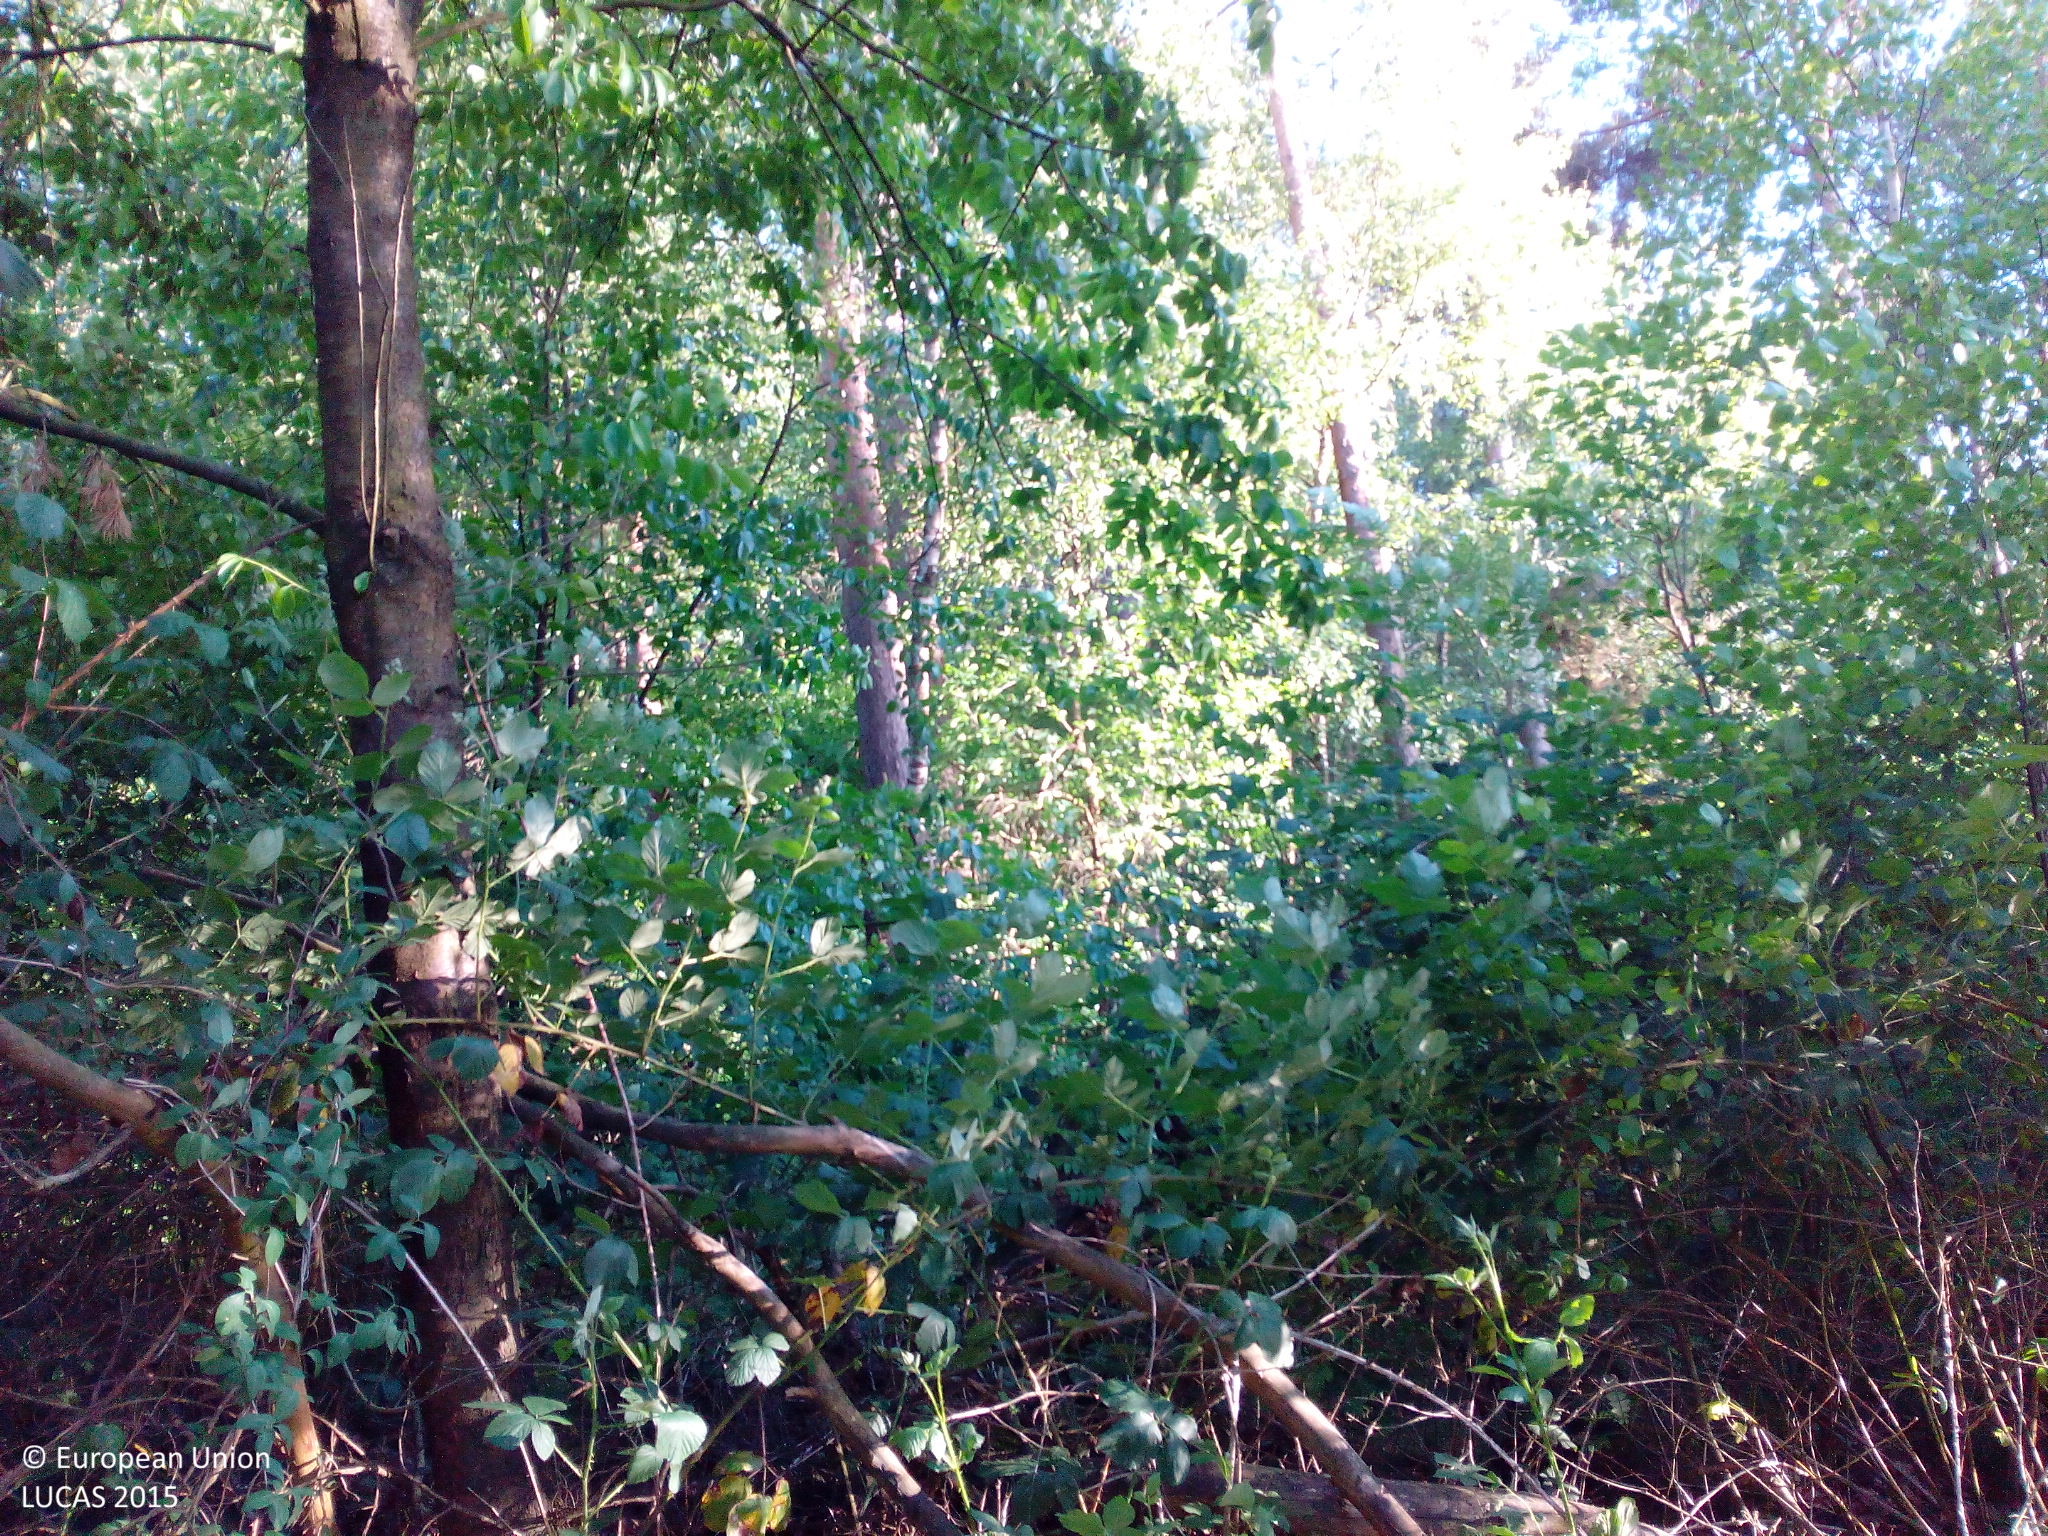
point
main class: Woodland
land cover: Pine dominated coniferous woodland
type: hemiboreal forest and nemoral coniferous forest and mixed broadleaved-coniferous forest
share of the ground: > 75 %
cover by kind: coniferous forest trees 70 %, broadleaved forest trees 15 %, shrubs 10 %, herbaceous plants 5 %
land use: Forestry
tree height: > 5 m
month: June
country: DE
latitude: 52.5101
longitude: 7.3629
